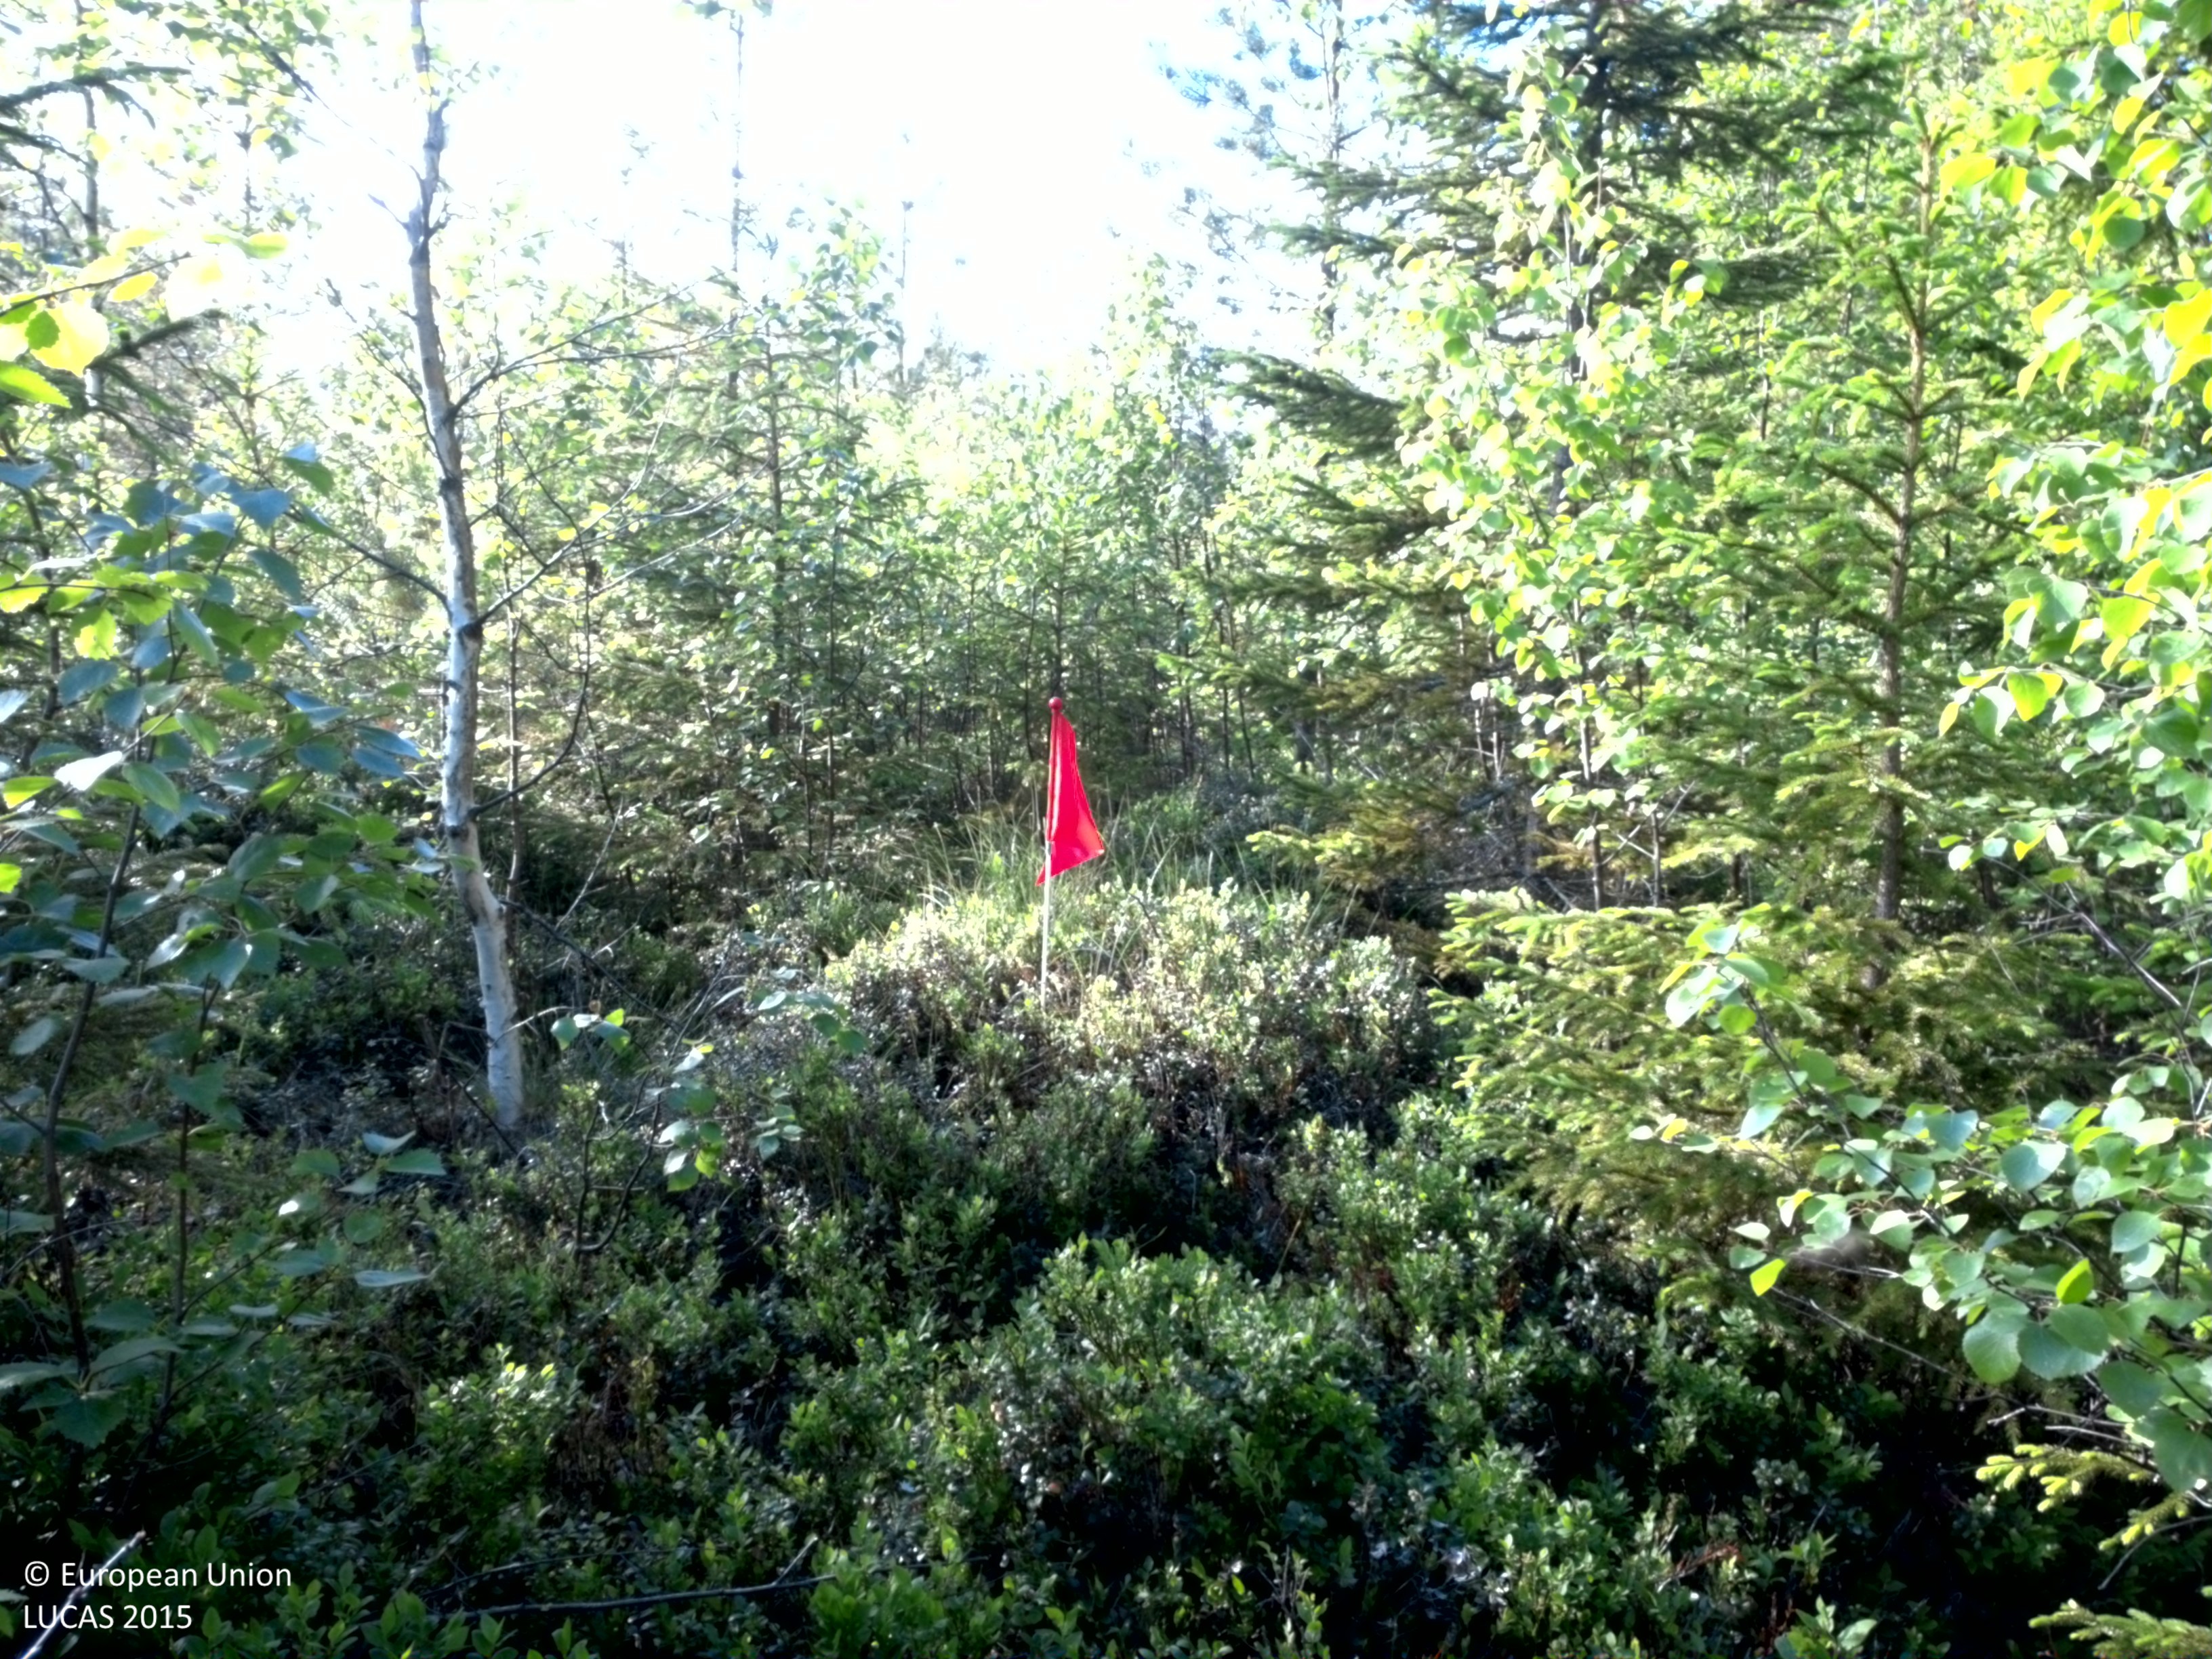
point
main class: Woodland
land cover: Spruce dominated mixed woodland
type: boreal forest
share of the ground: 25 - 50 %
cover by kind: coniferous forest trees 30 %, shrubs 25 %, herbaceous plants 25 %, broadleaved forest trees 20 %
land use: Forestry
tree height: < 5 m
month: June
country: SE
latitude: 64.2198
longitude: 20.6766
